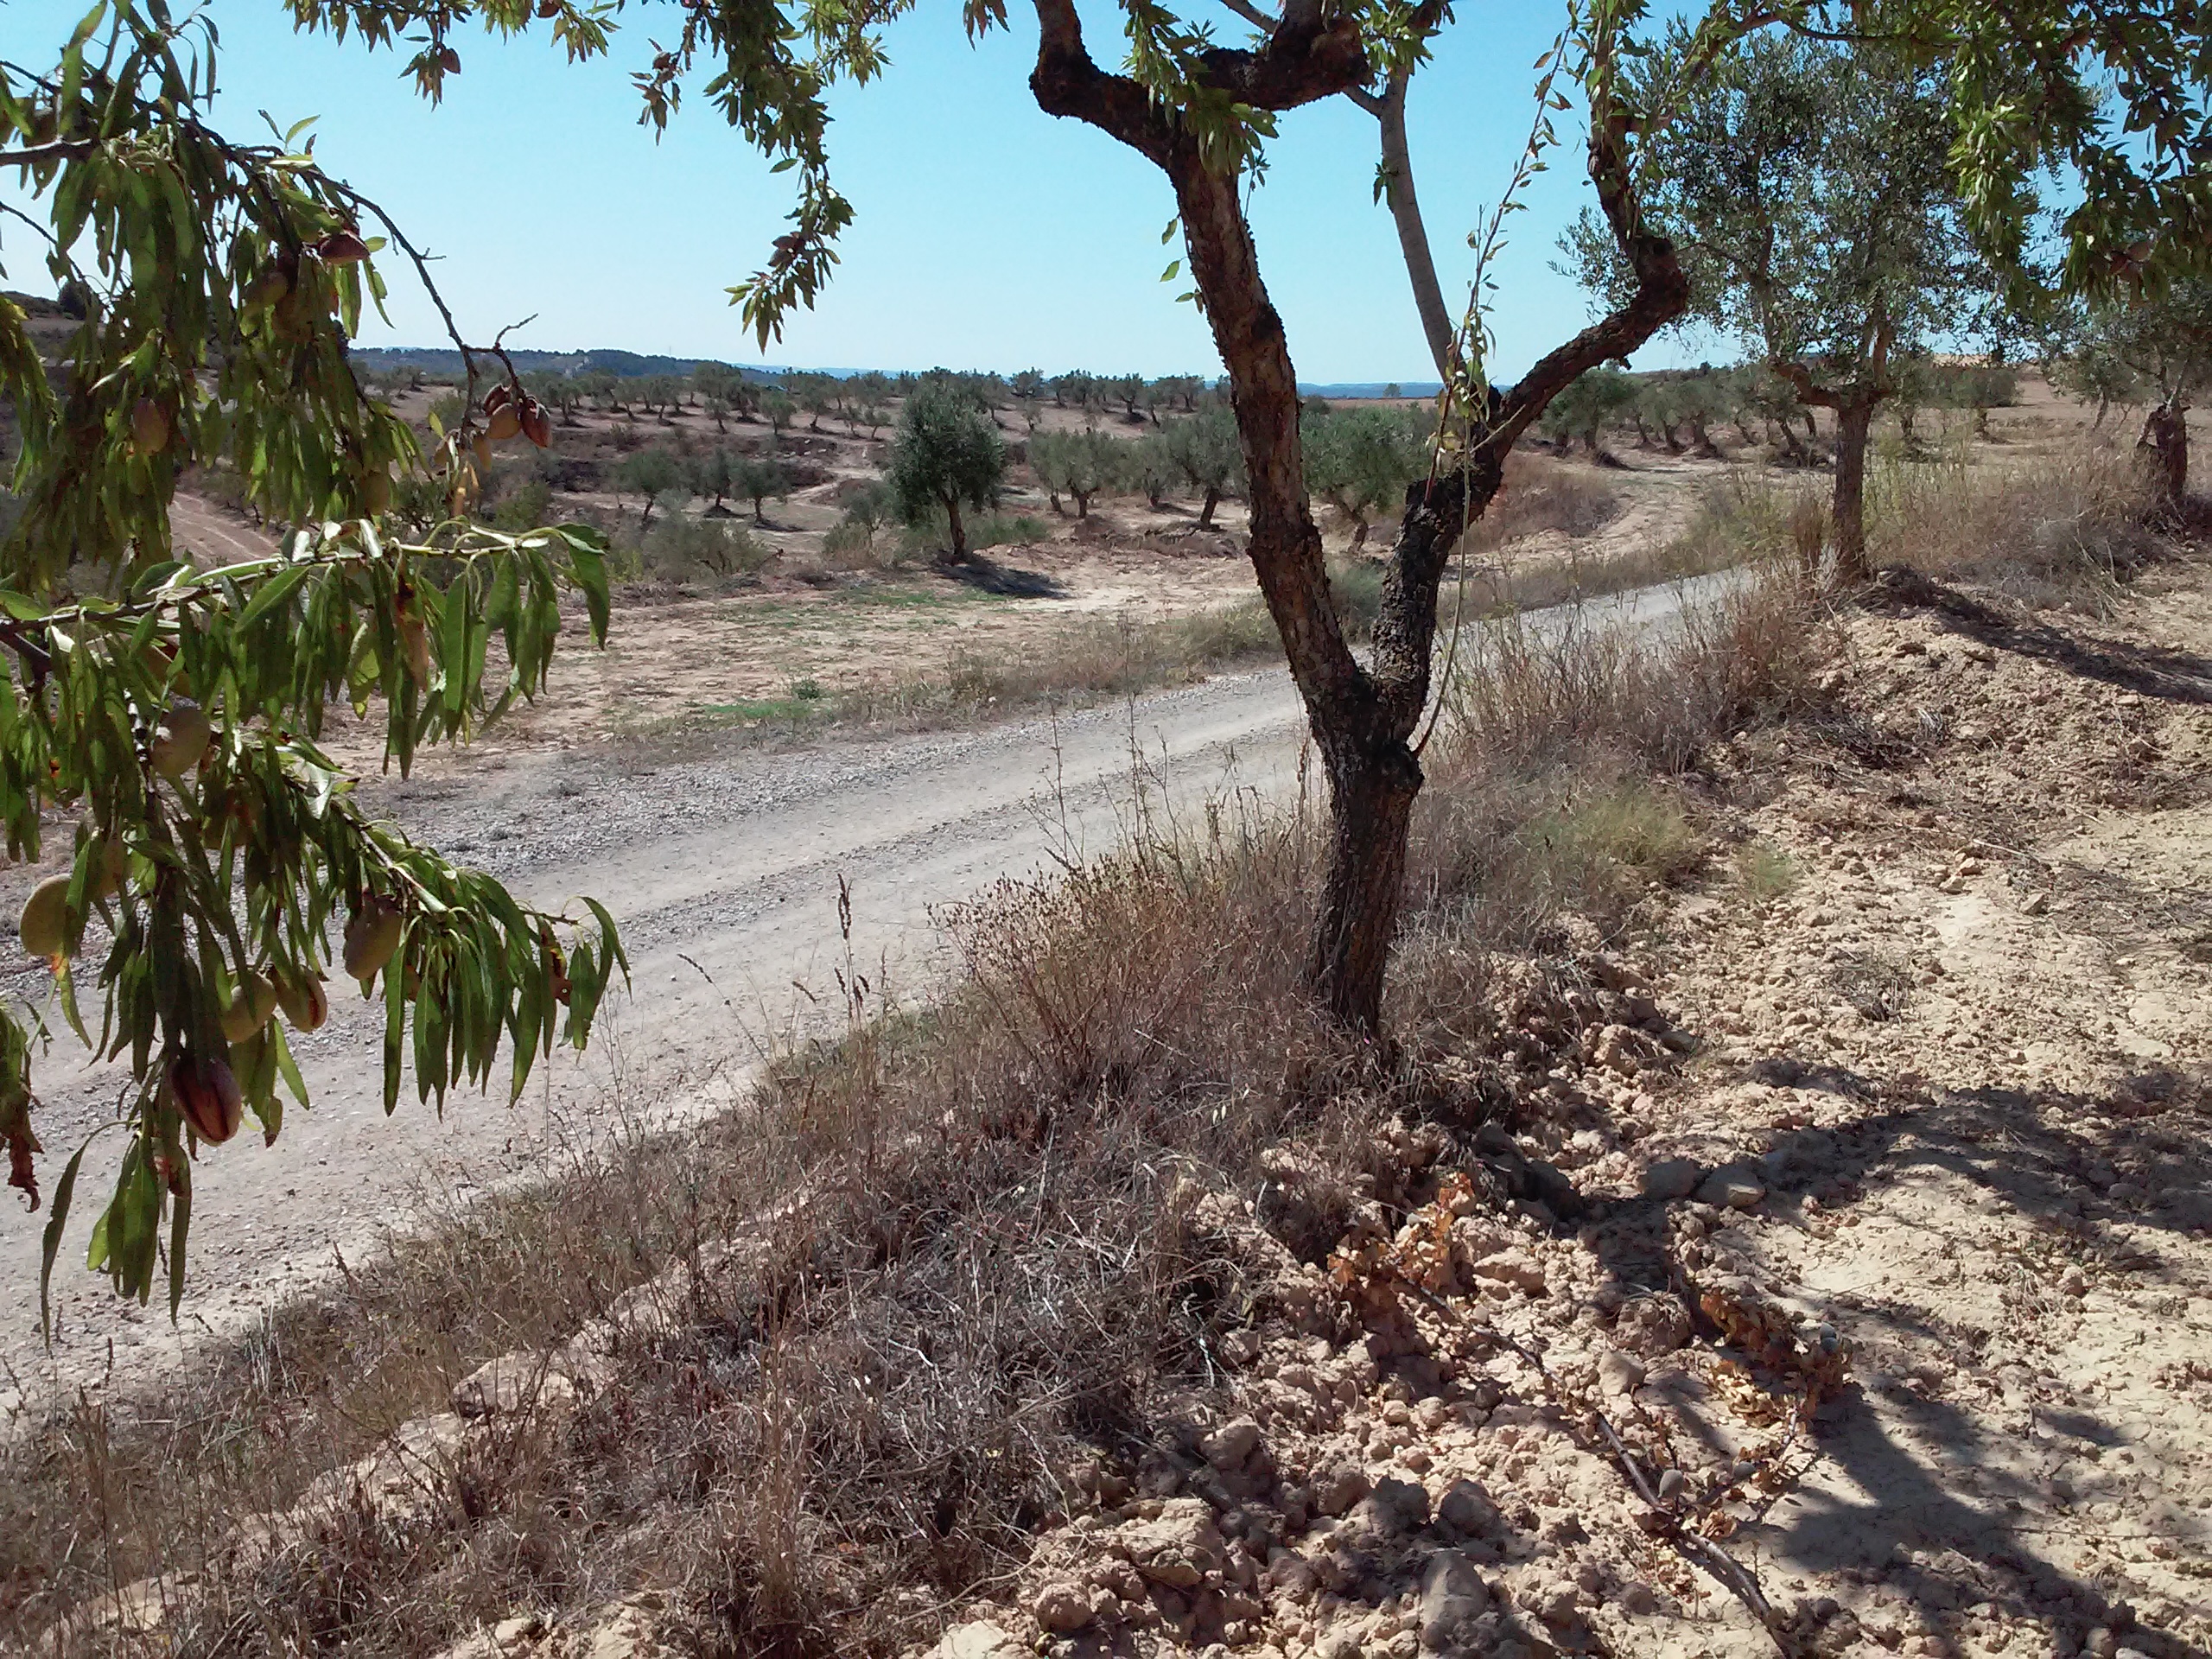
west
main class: Cropland
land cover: Nuts trees
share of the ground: 25 - 50 %
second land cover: Other bare soil
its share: > 75 %
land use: Agriculture (excluding fallow land and kitchen gardens)
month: August
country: ES
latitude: 41.3532
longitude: 0.5109
